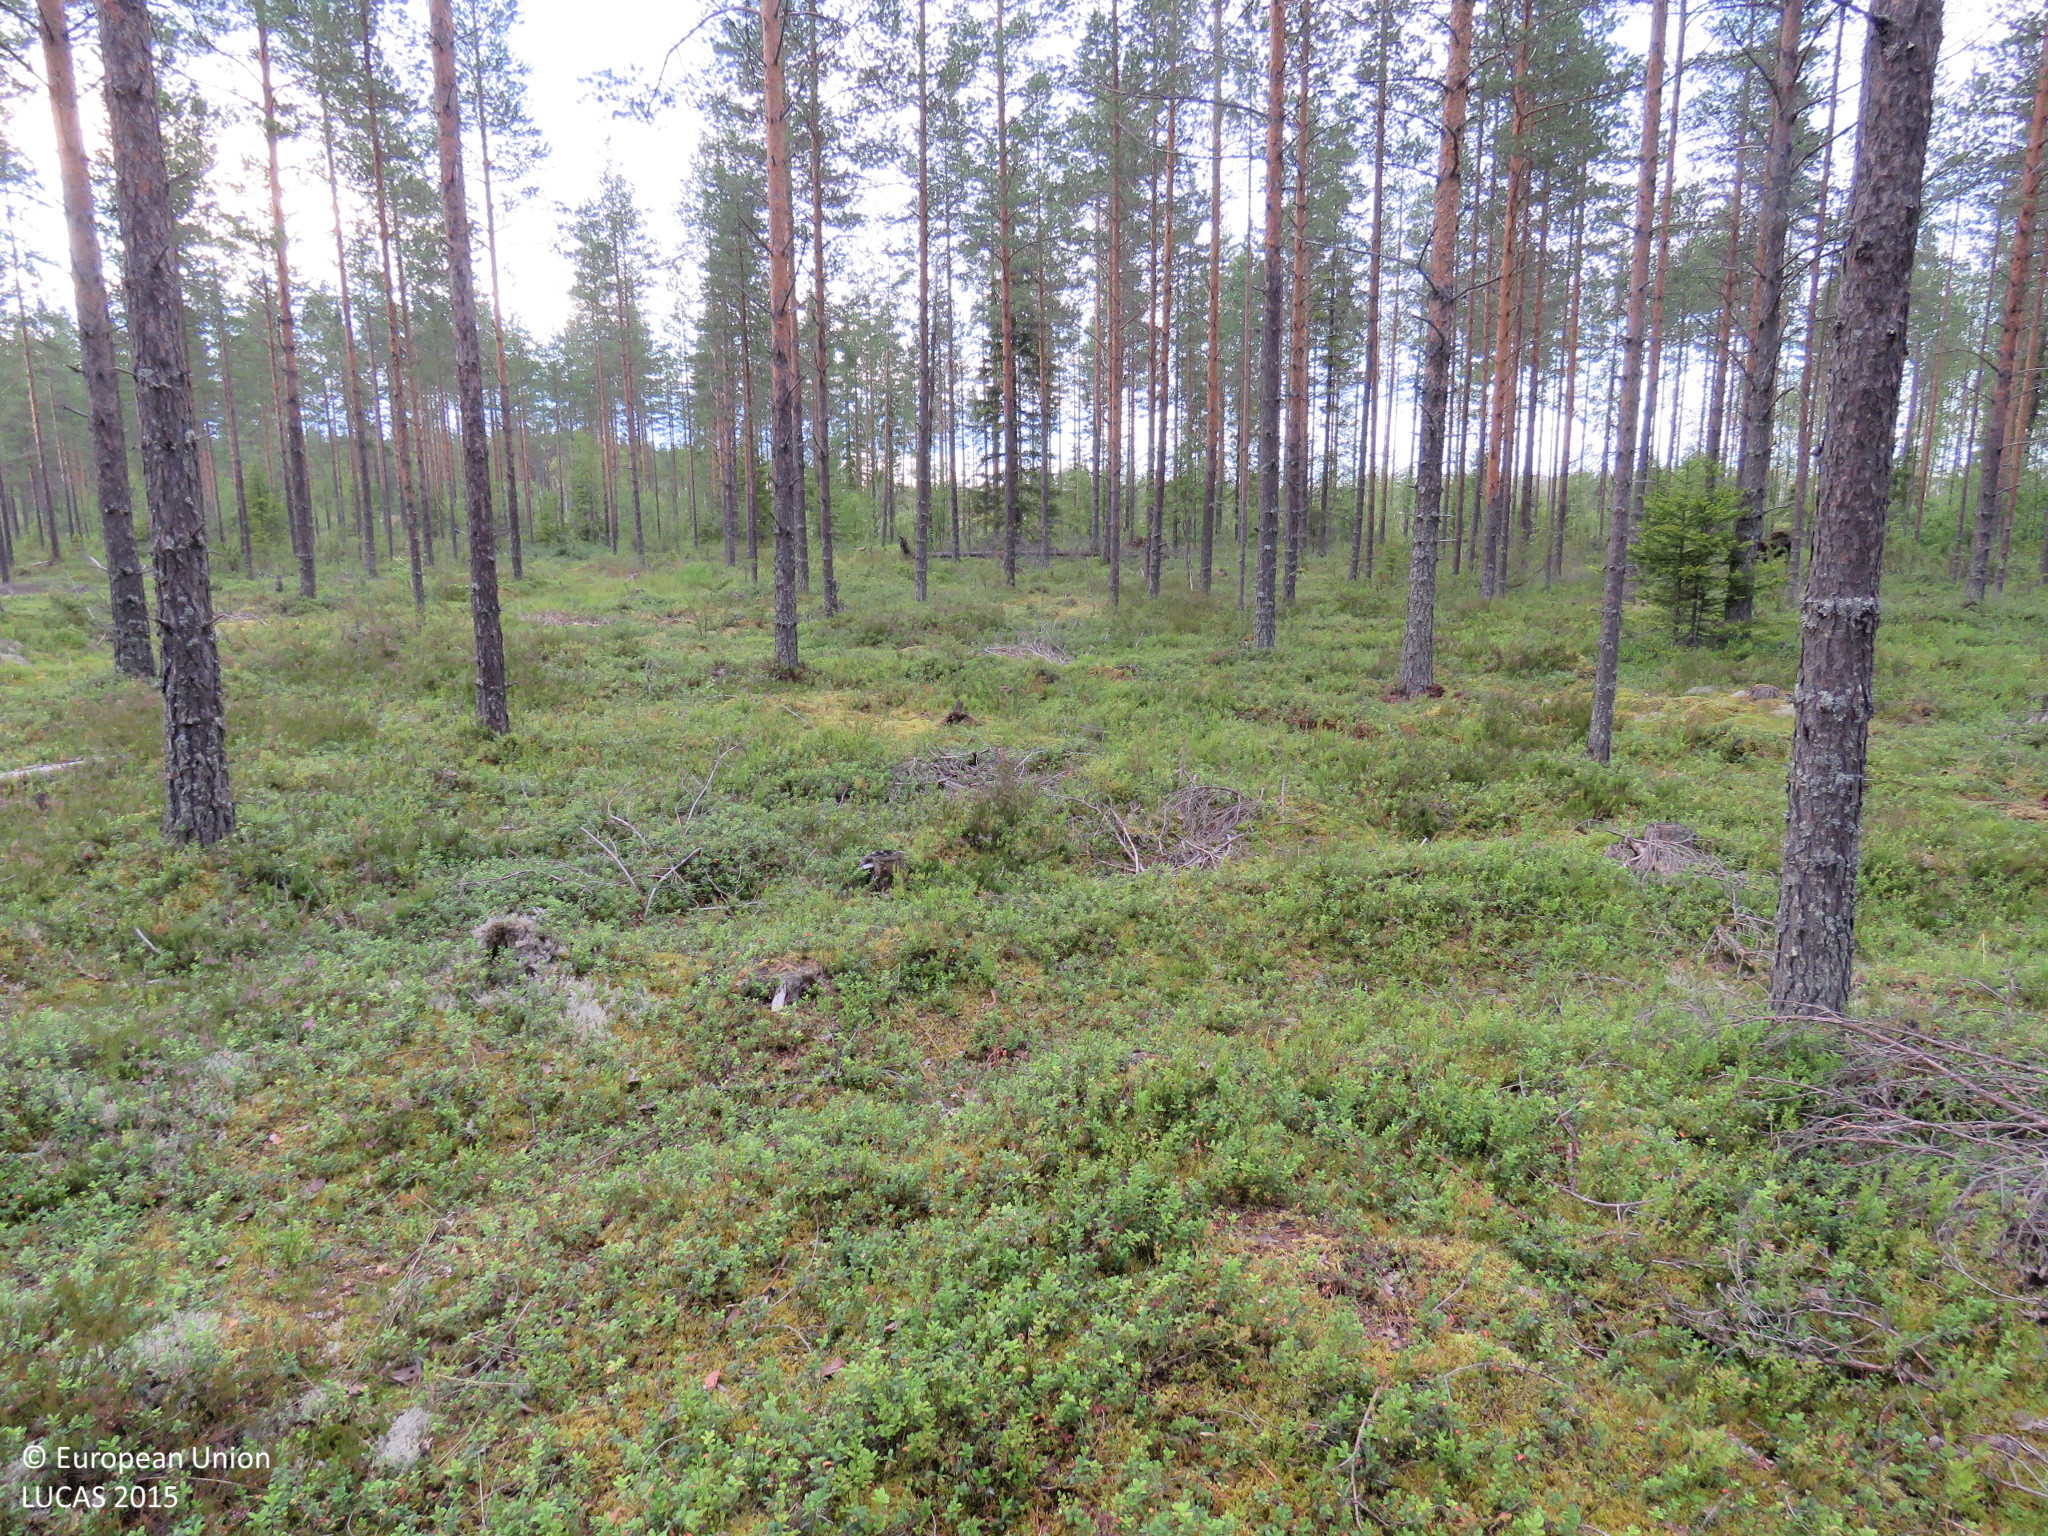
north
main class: Woodland
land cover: Pine dominated coniferous woodland
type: boreal forest
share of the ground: 50 - 75 %
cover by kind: coniferous forest trees 50 %, shrubs 40 %, lichens and mosses 10 %
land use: Forestry
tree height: > 5 m
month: July
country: FI
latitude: 64.7299
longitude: 26.5089
